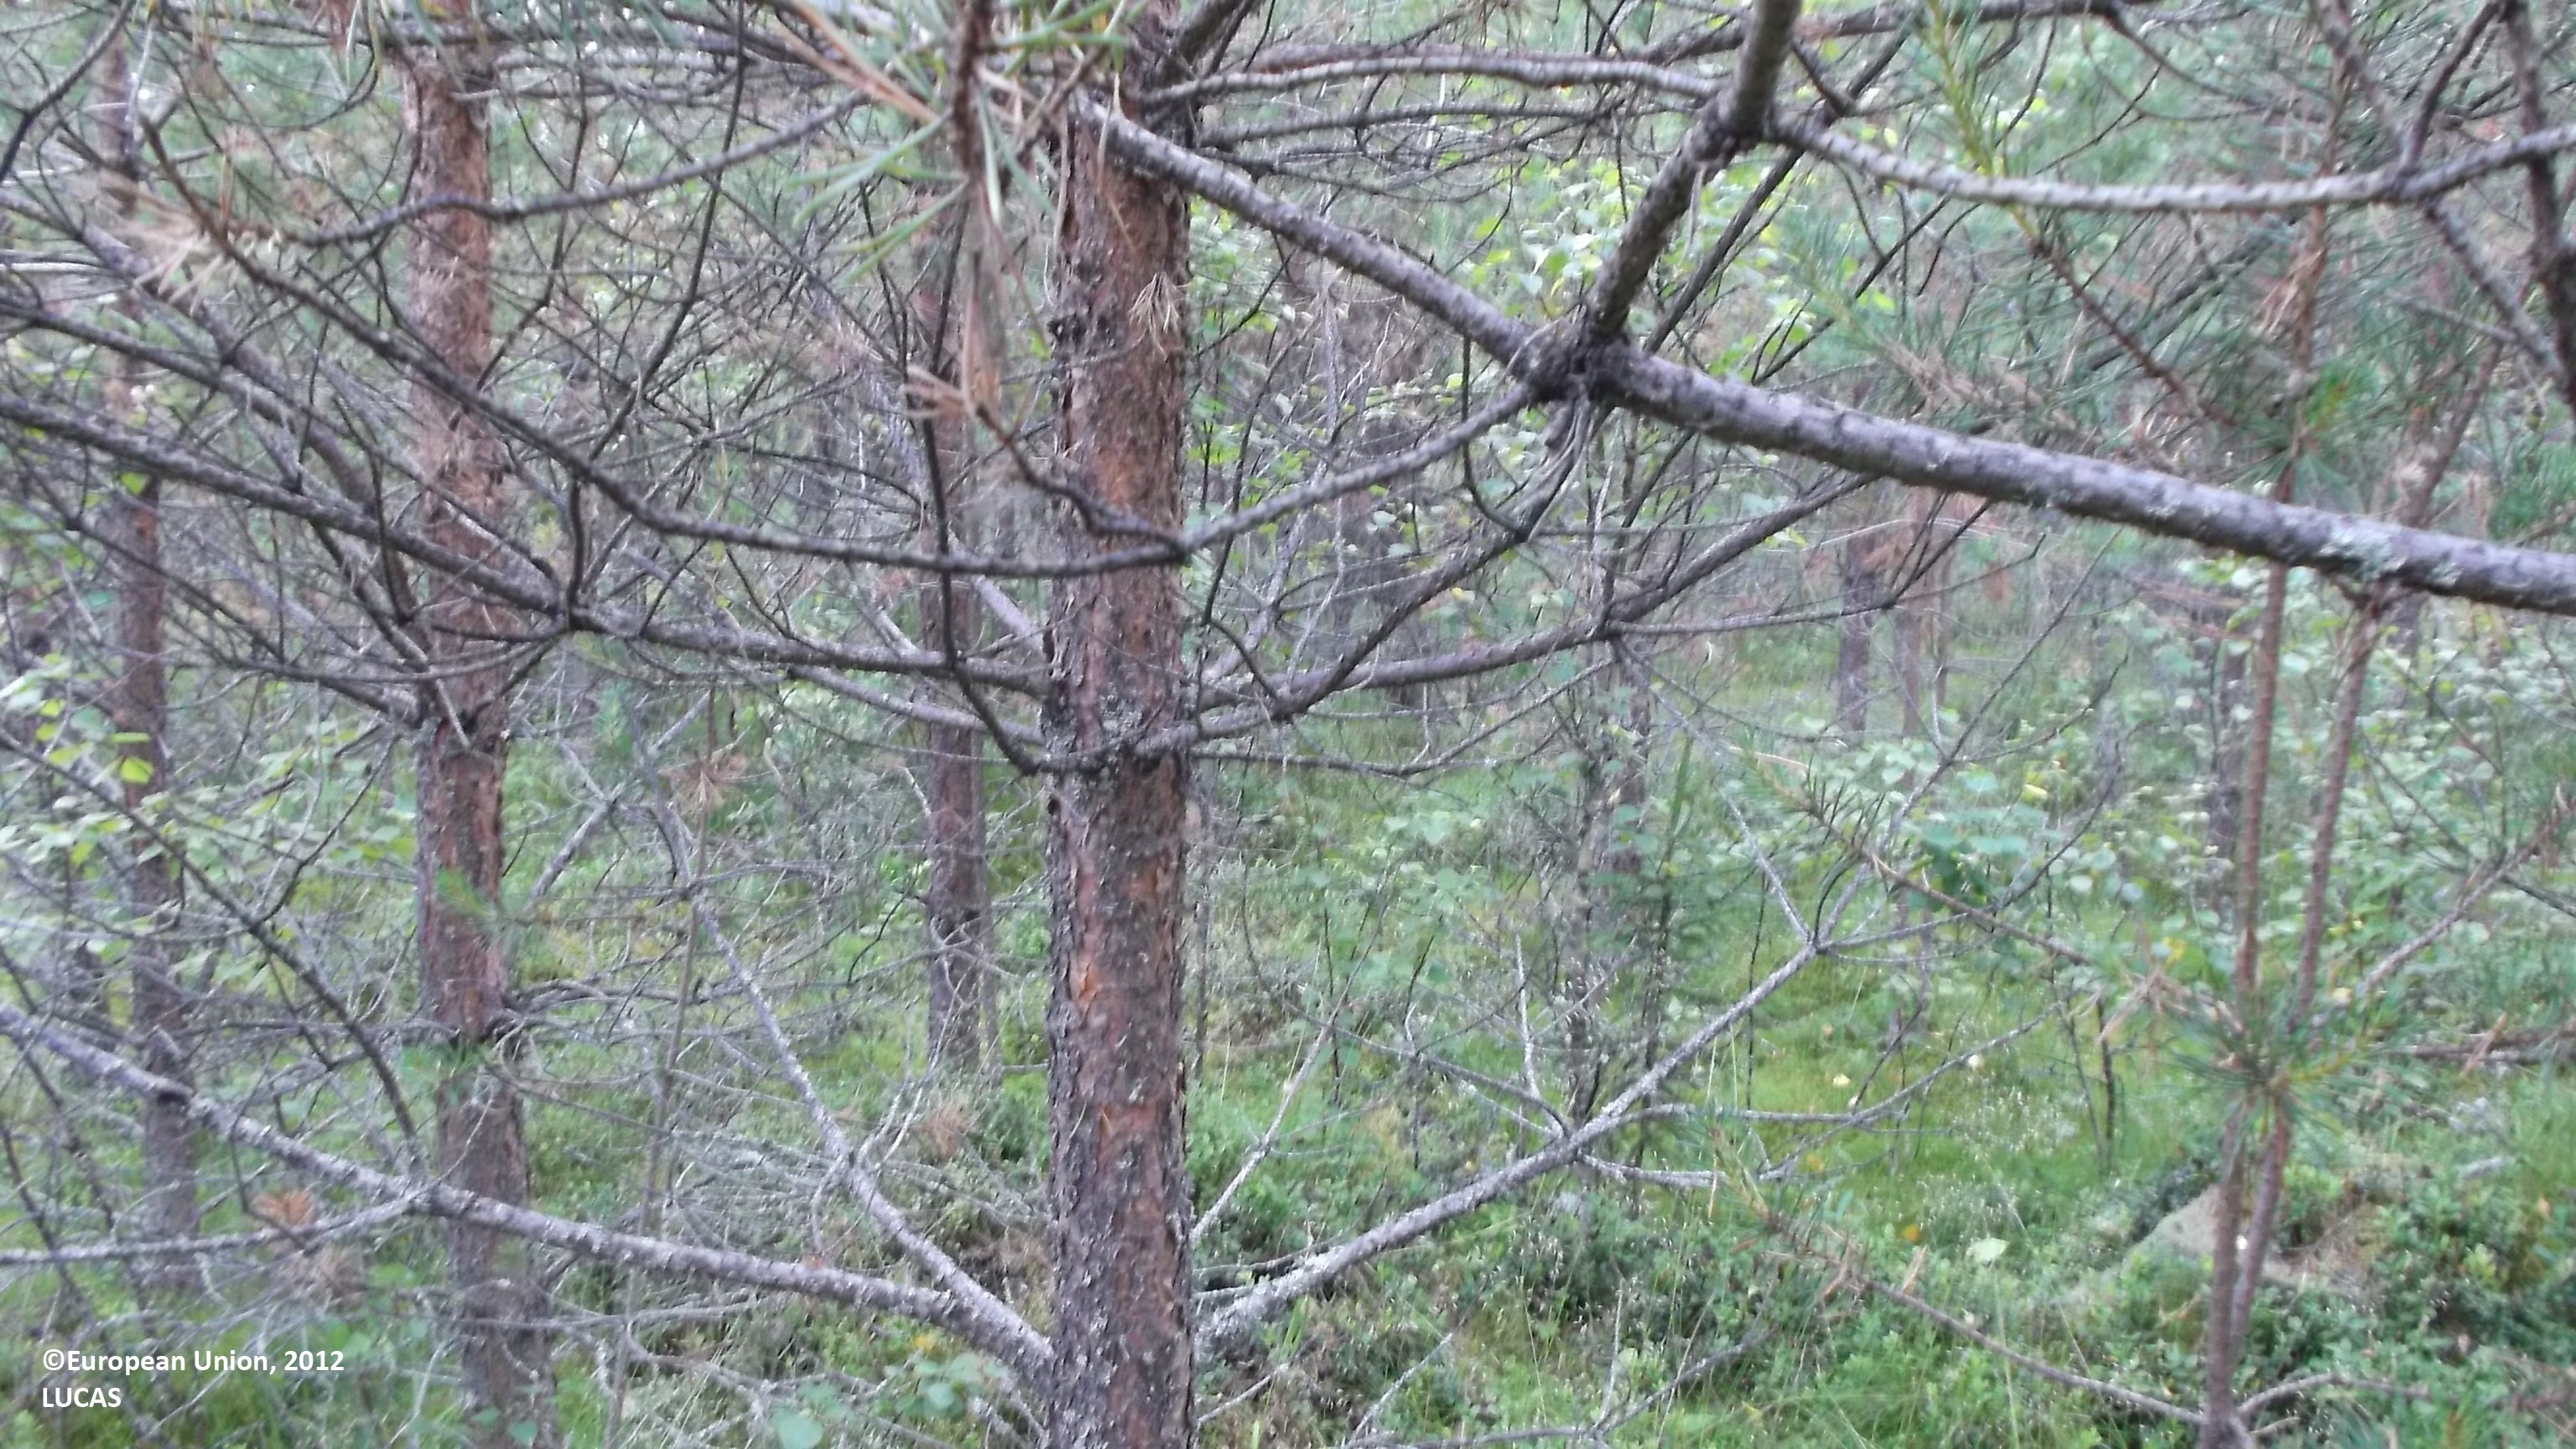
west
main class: Woodland
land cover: Pine dominated mixed woodland
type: boreal forest
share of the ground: > 75 %
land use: Forestry
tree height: > 5 m
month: July
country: FI
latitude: 63.6068
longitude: 23.1821
